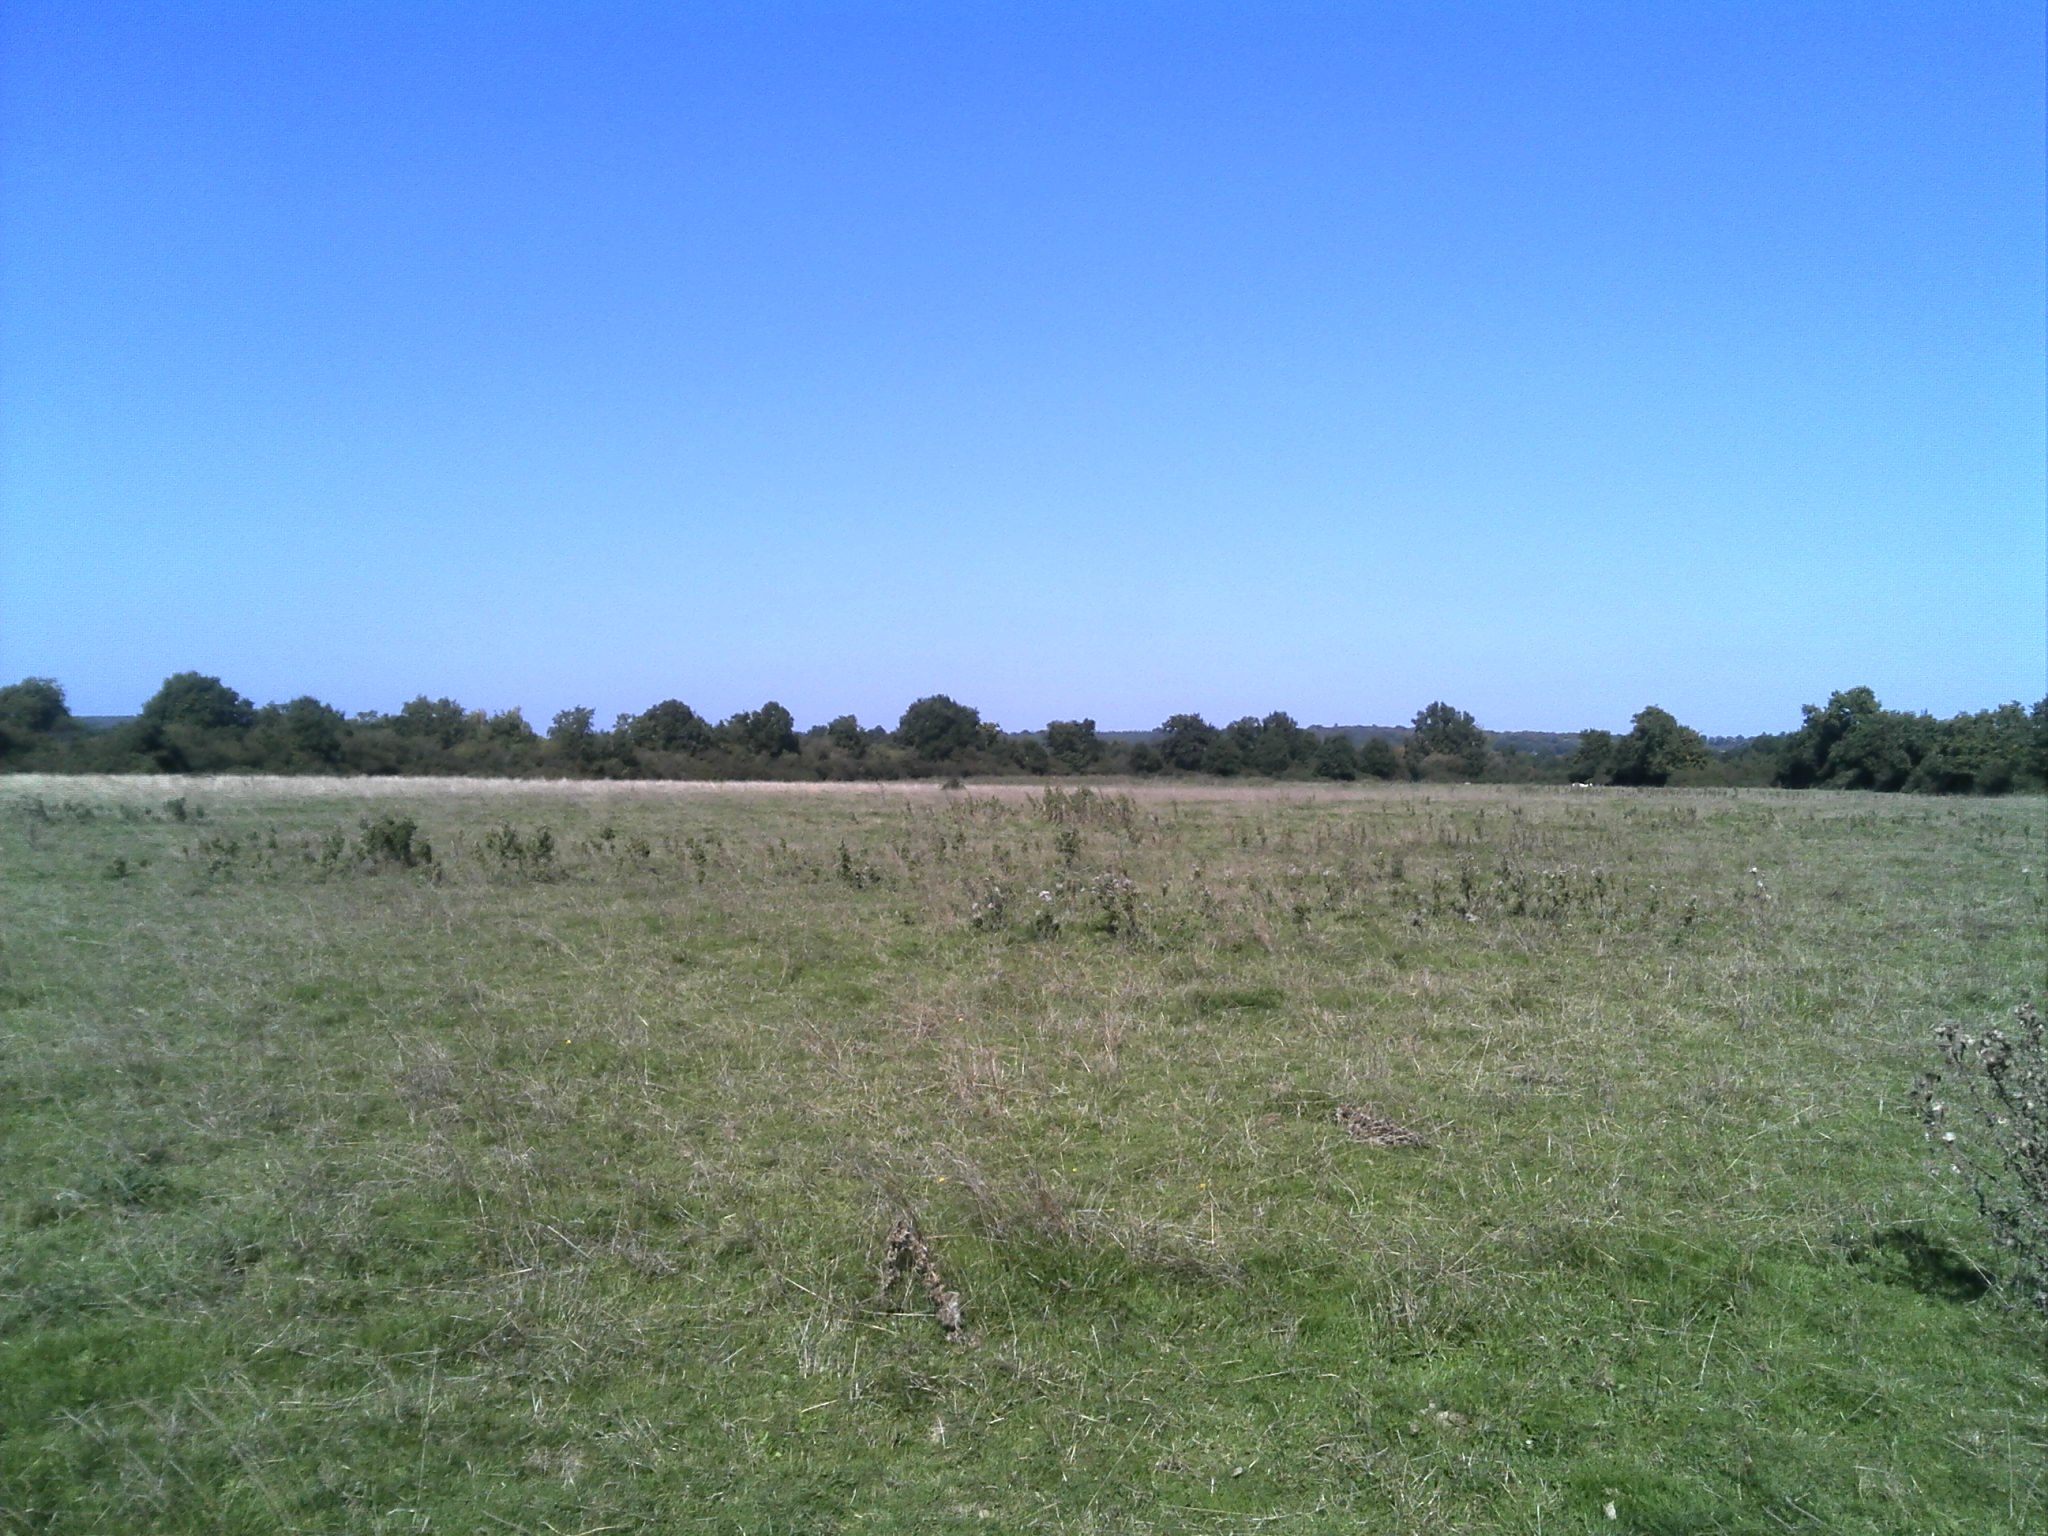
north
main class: Grassland
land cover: Grassland without tree/shrub cover
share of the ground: > 75 %
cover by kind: herbaceous plants 100 %
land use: Agriculture (excluding fallow land and kitchen gardens)
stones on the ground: < 10 %
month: October
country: FR
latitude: 47.5826
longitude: -0.9794
